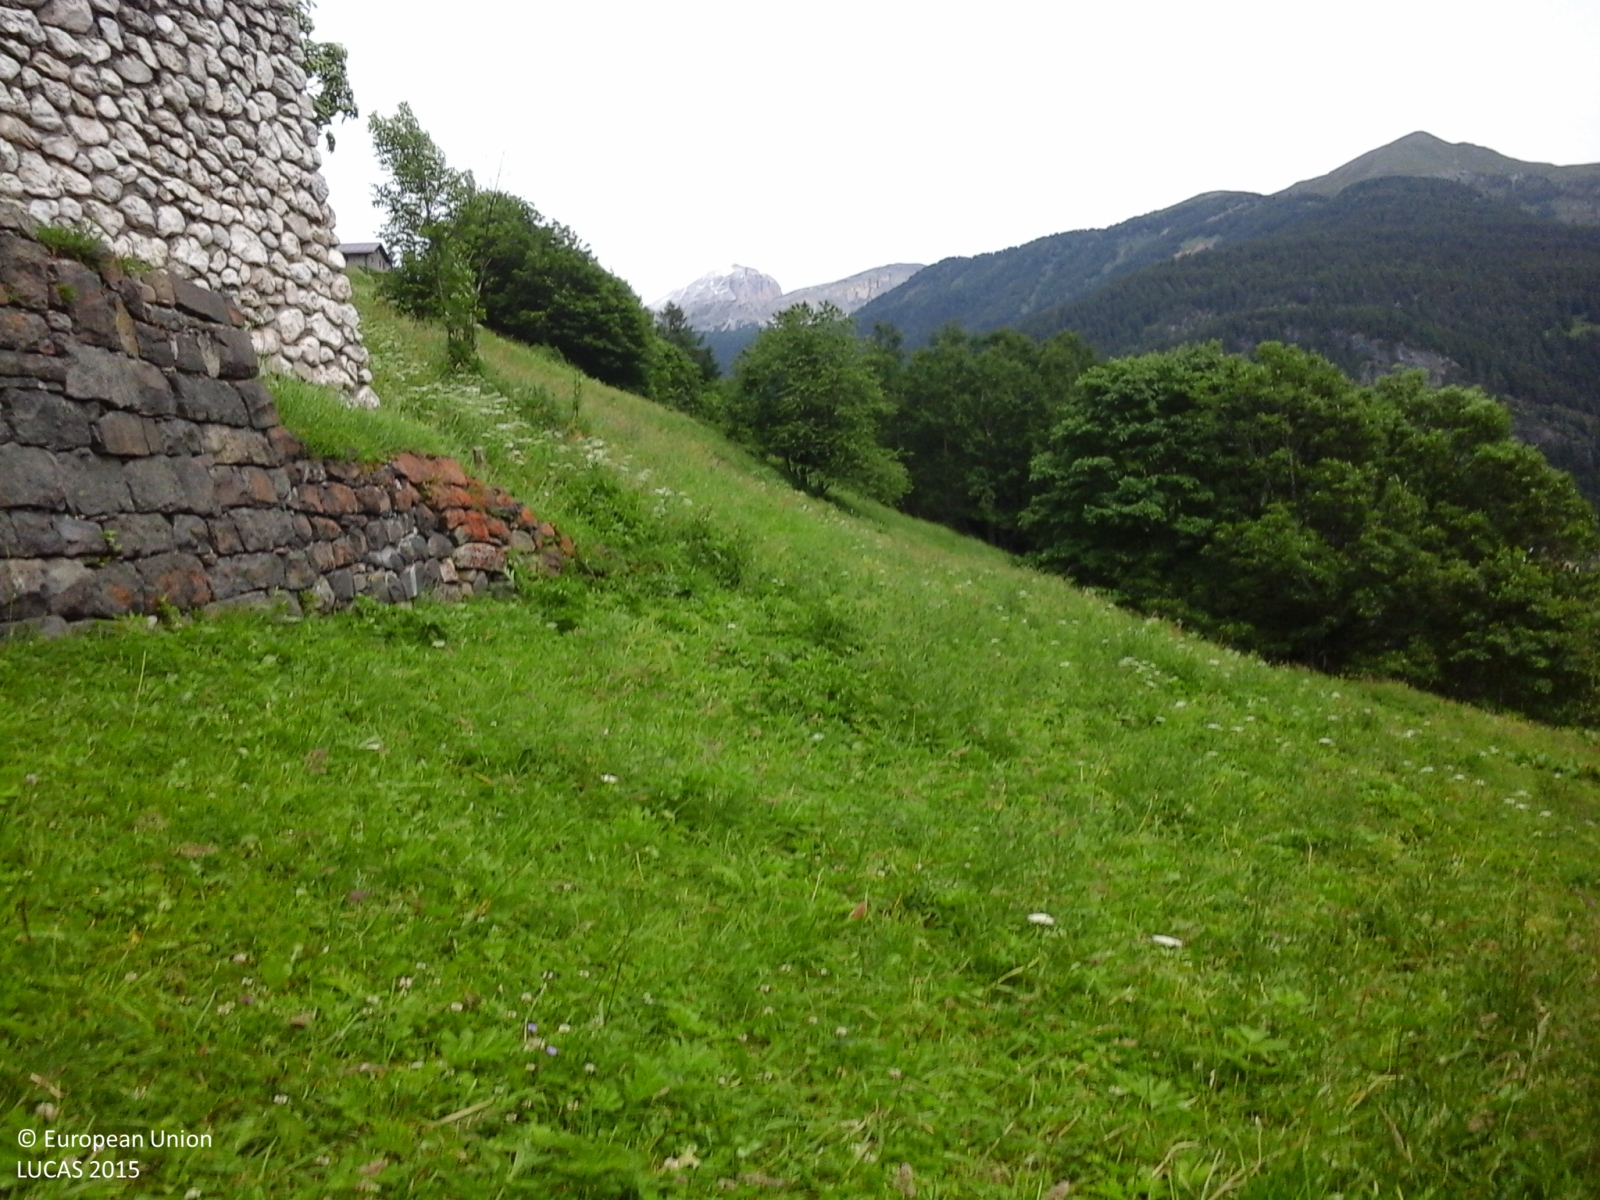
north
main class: Grassland
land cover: Grassland without tree/shrub cover
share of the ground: > 75 %
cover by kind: herbaceous plants 100 %
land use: Agriculture (excluding fallow land and kitchen gardens)
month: June
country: IT
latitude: 46.4593
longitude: 11.9638
